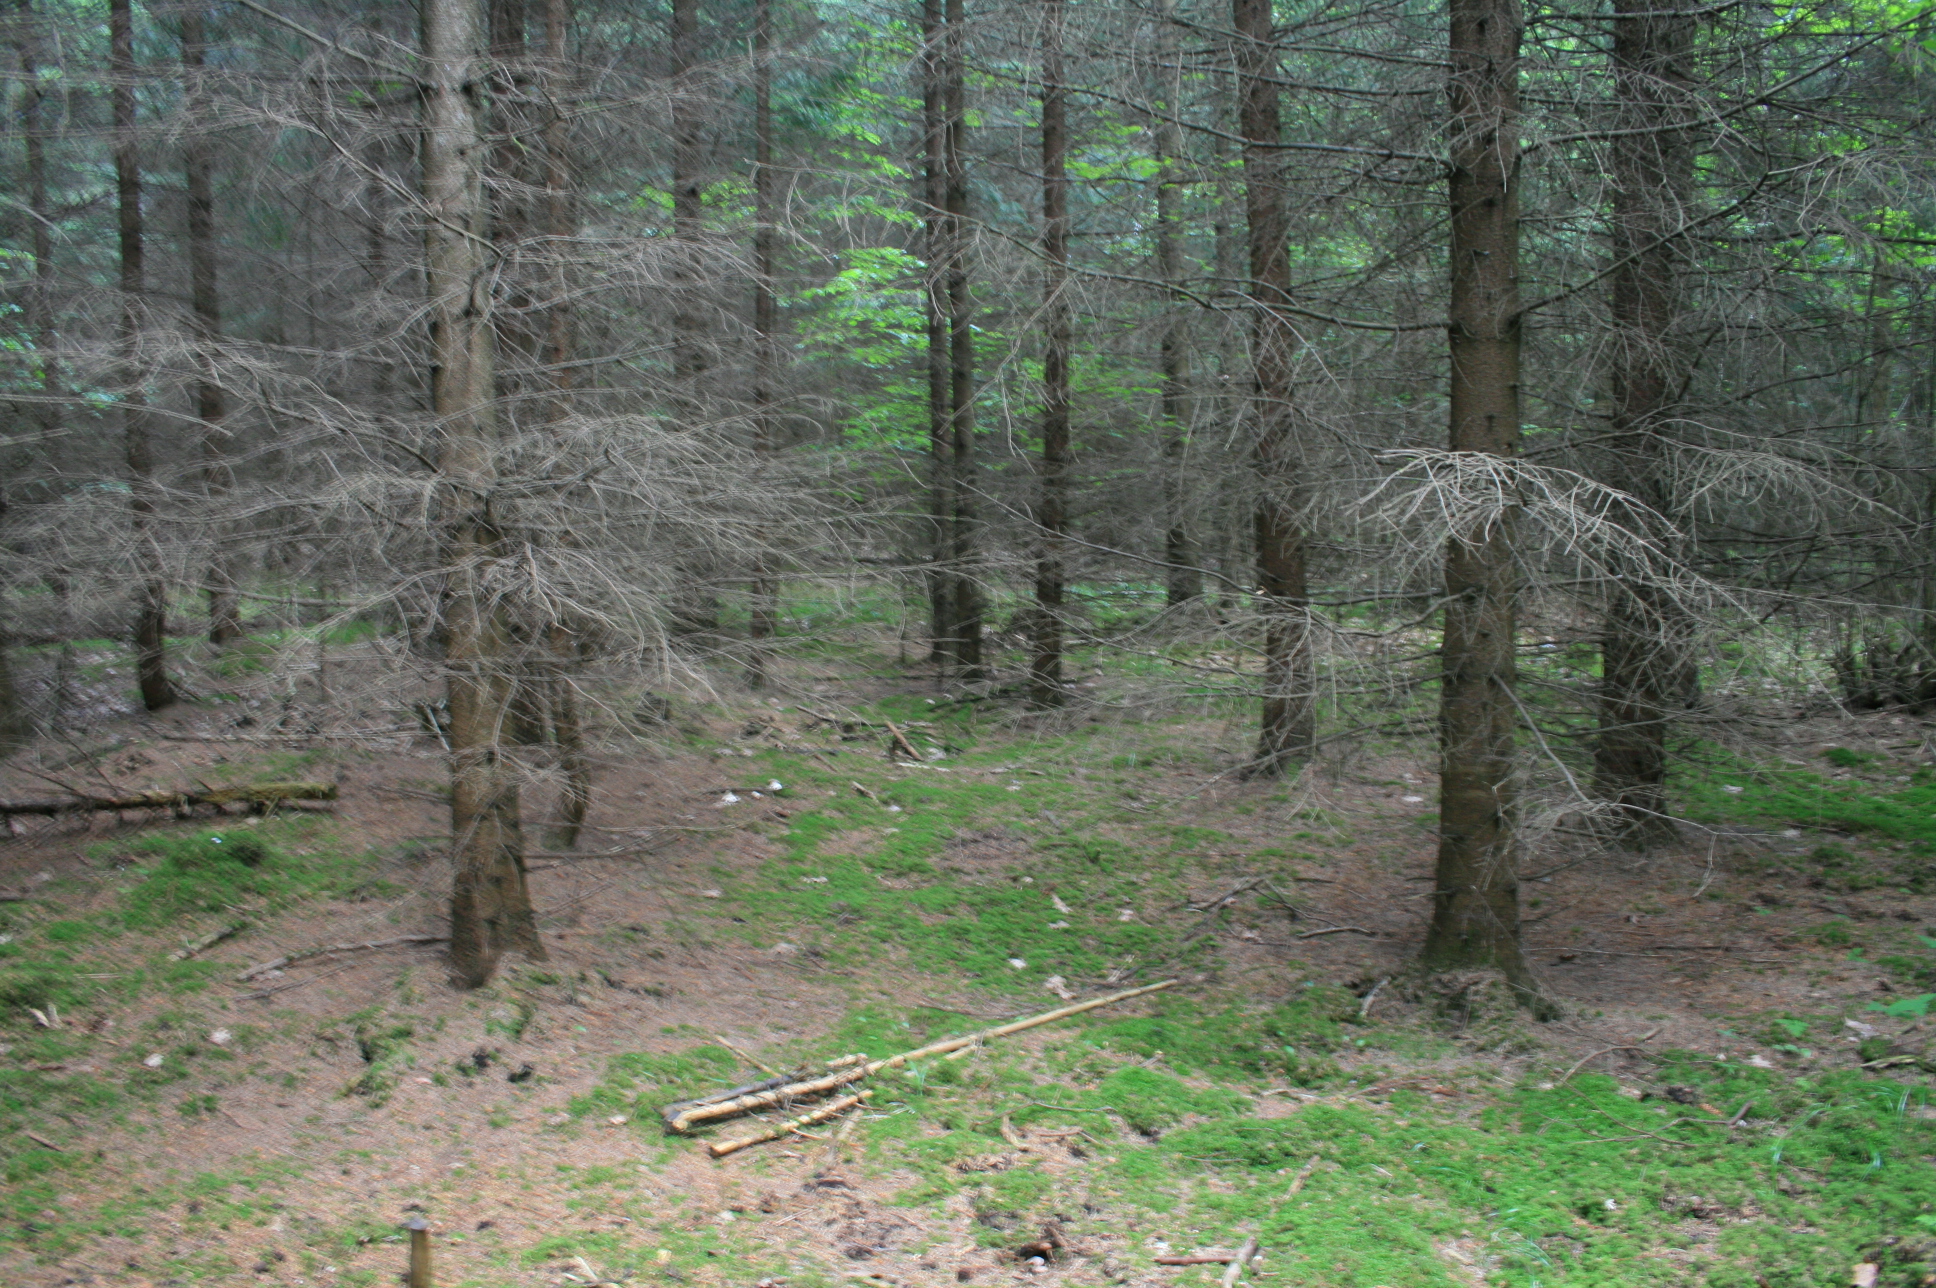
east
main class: Woodland
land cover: Spruce dominated coniferous woodland
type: hemiboreal forest and nemoral coniferous forest and mixed broadleaved-coniferous forest
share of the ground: > 75 %
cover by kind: coniferous forest trees 95 %, lichens and mosses 5 %
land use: Forestry
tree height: > 5 m
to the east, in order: Spruce dominated coniferous woodland; Broadleaved woodland; Tracks; Spruce dominated coniferous woodland; Tracks; Spruce dominated coniferous woodland; Broadleaved woodland
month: July
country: LT
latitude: 55.4208
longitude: 21.8209
